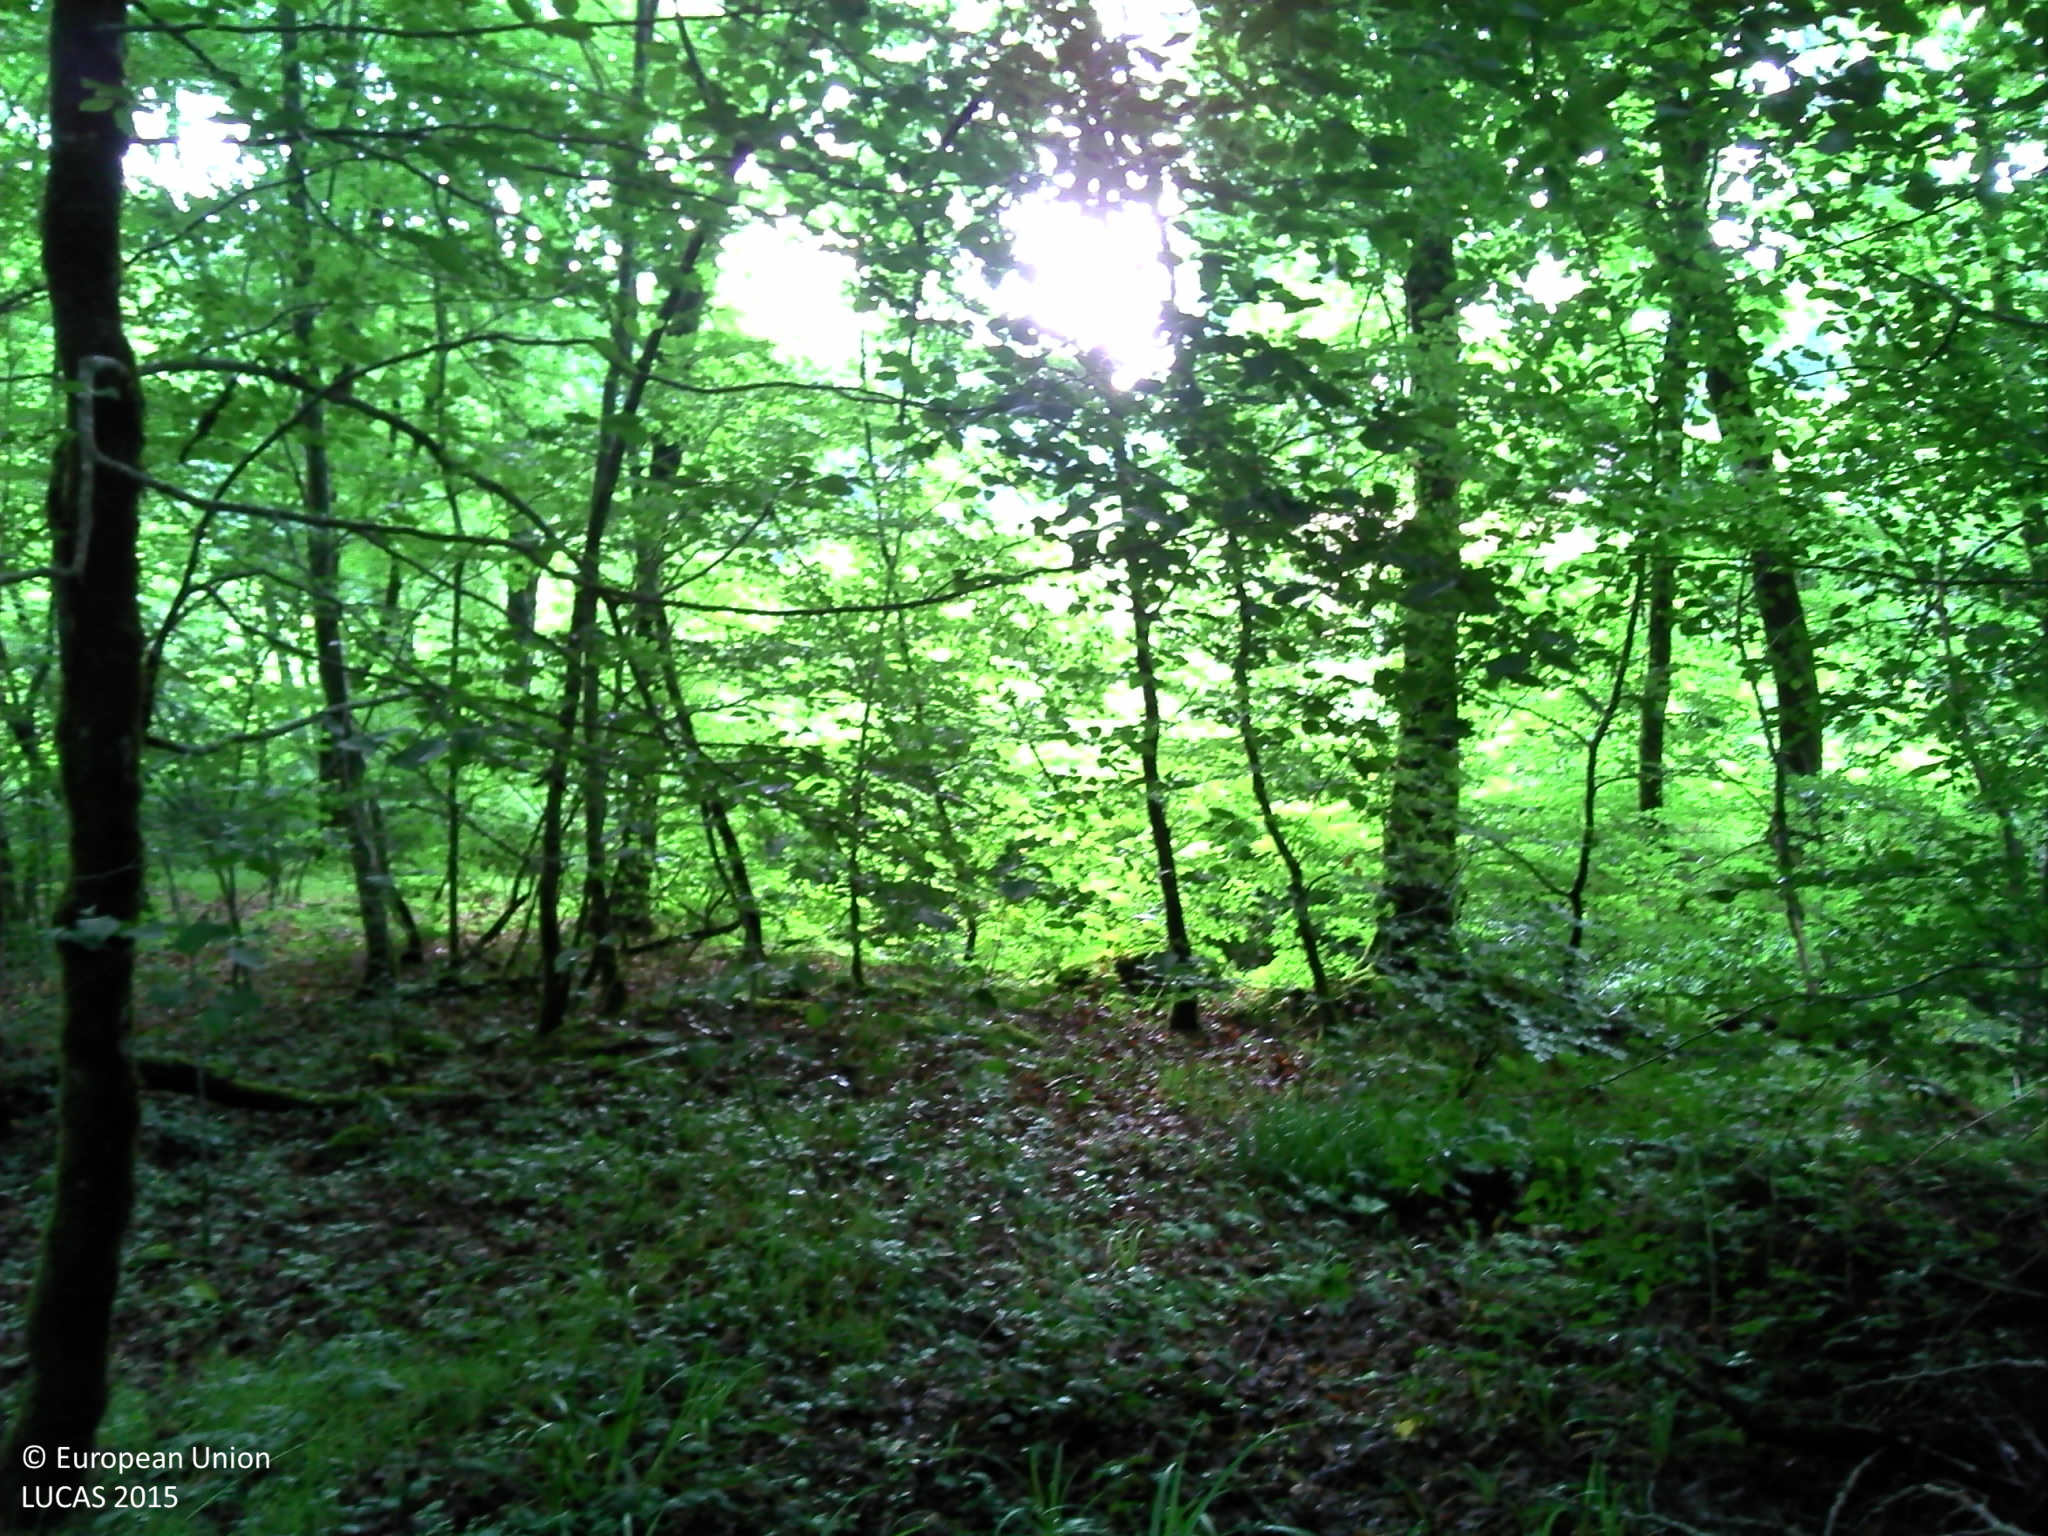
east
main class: Woodland
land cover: Broadleaved woodland
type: acidophilous oak and oak-birch forest
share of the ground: > 75 %
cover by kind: broadleaved forest trees 85 %, herbaceous plants 10 %, unconsolidated bare surface 5 %
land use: Forestry
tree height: > 5 m
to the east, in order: Broadleaved woodland; Rivers and streams; Broadleaved woodland; Rivers and streams; Shrubland with sparse tree cover; Tracks; Broadleaved woodland; Grass margins; Paved roads, cycling and walking lanes; Grass margins; Broadleaved woodland
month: June
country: FR
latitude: 46.5880
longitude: 2.6738
